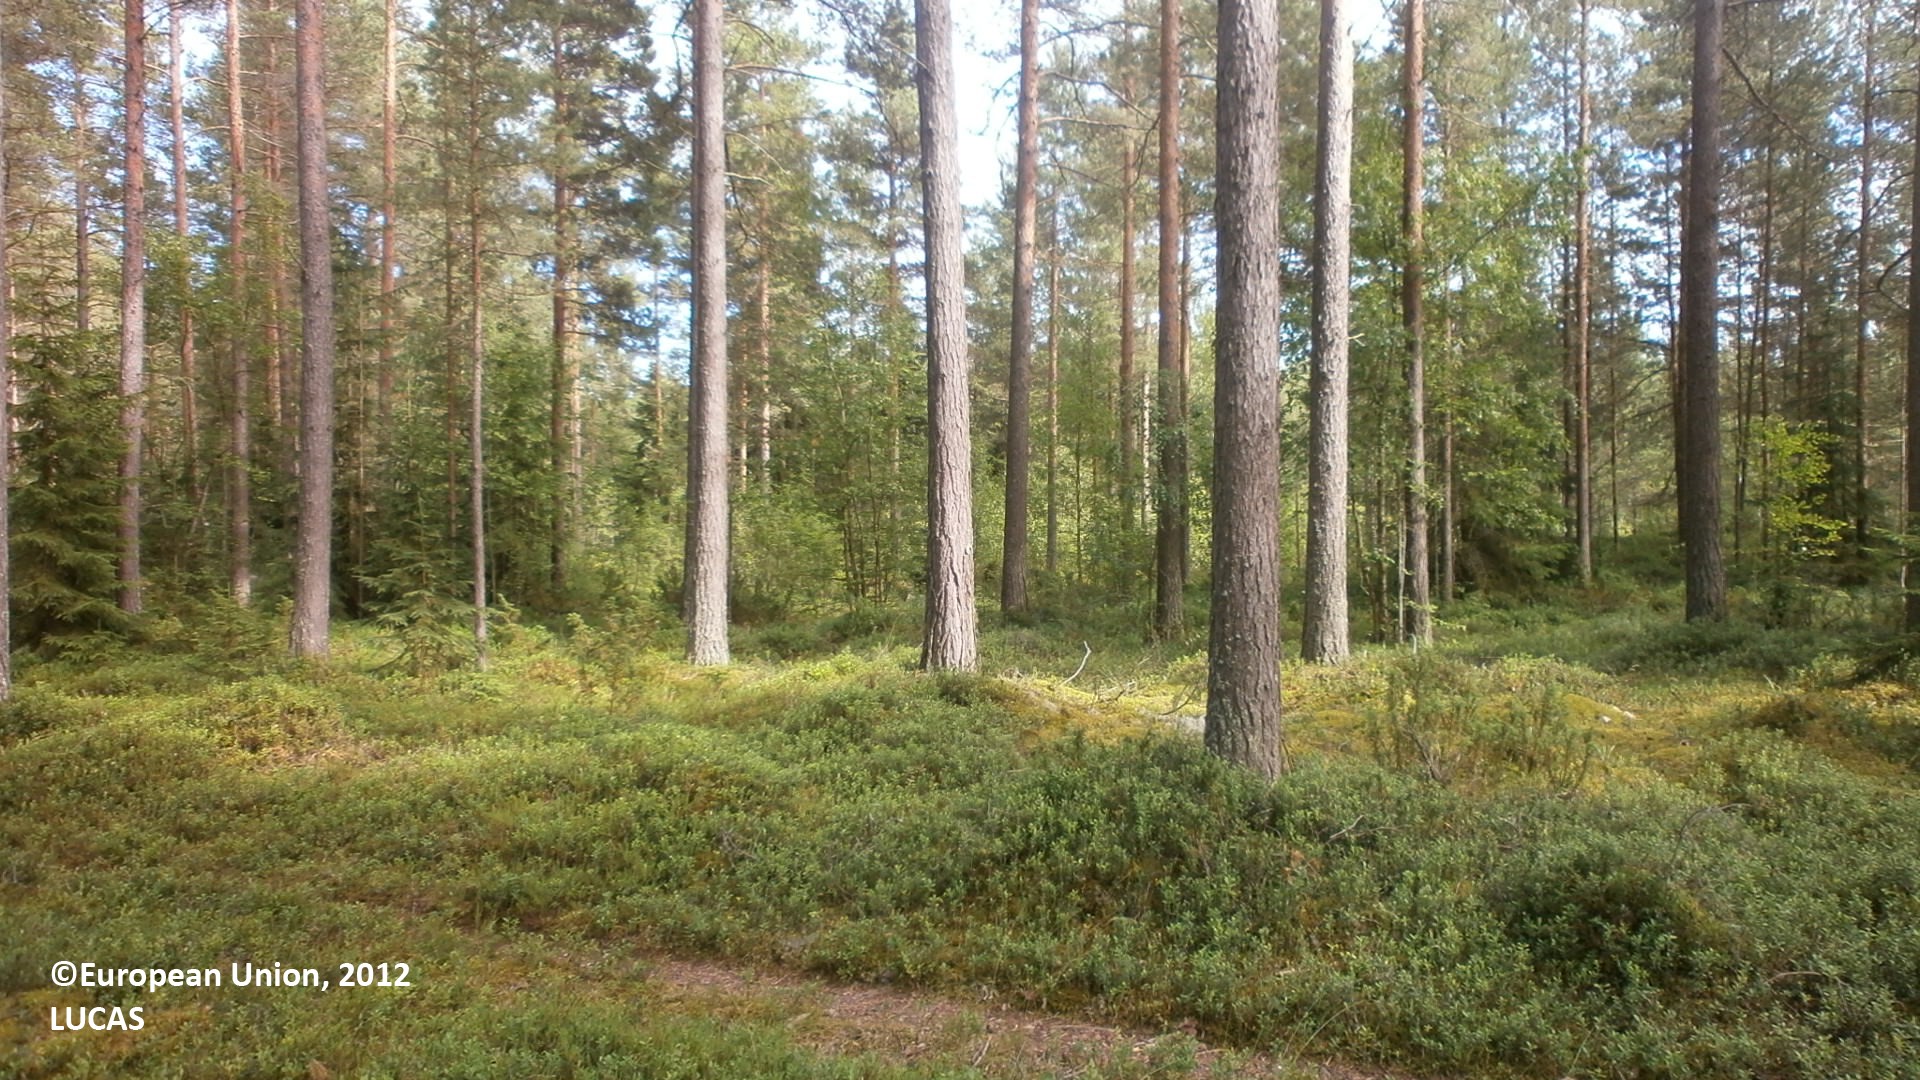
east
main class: Woodland
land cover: Pine dominated coniferous woodland
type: boreal forest
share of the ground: 50 - 75 %
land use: Forestry
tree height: > 5 m
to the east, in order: Pine dominated coniferous woodland; Tracks; Pine dominated coniferous woodland; Electric lines; Tracks; Pine dominated coniferous woodland
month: July
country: FI
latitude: 64.2461
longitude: 23.8601
